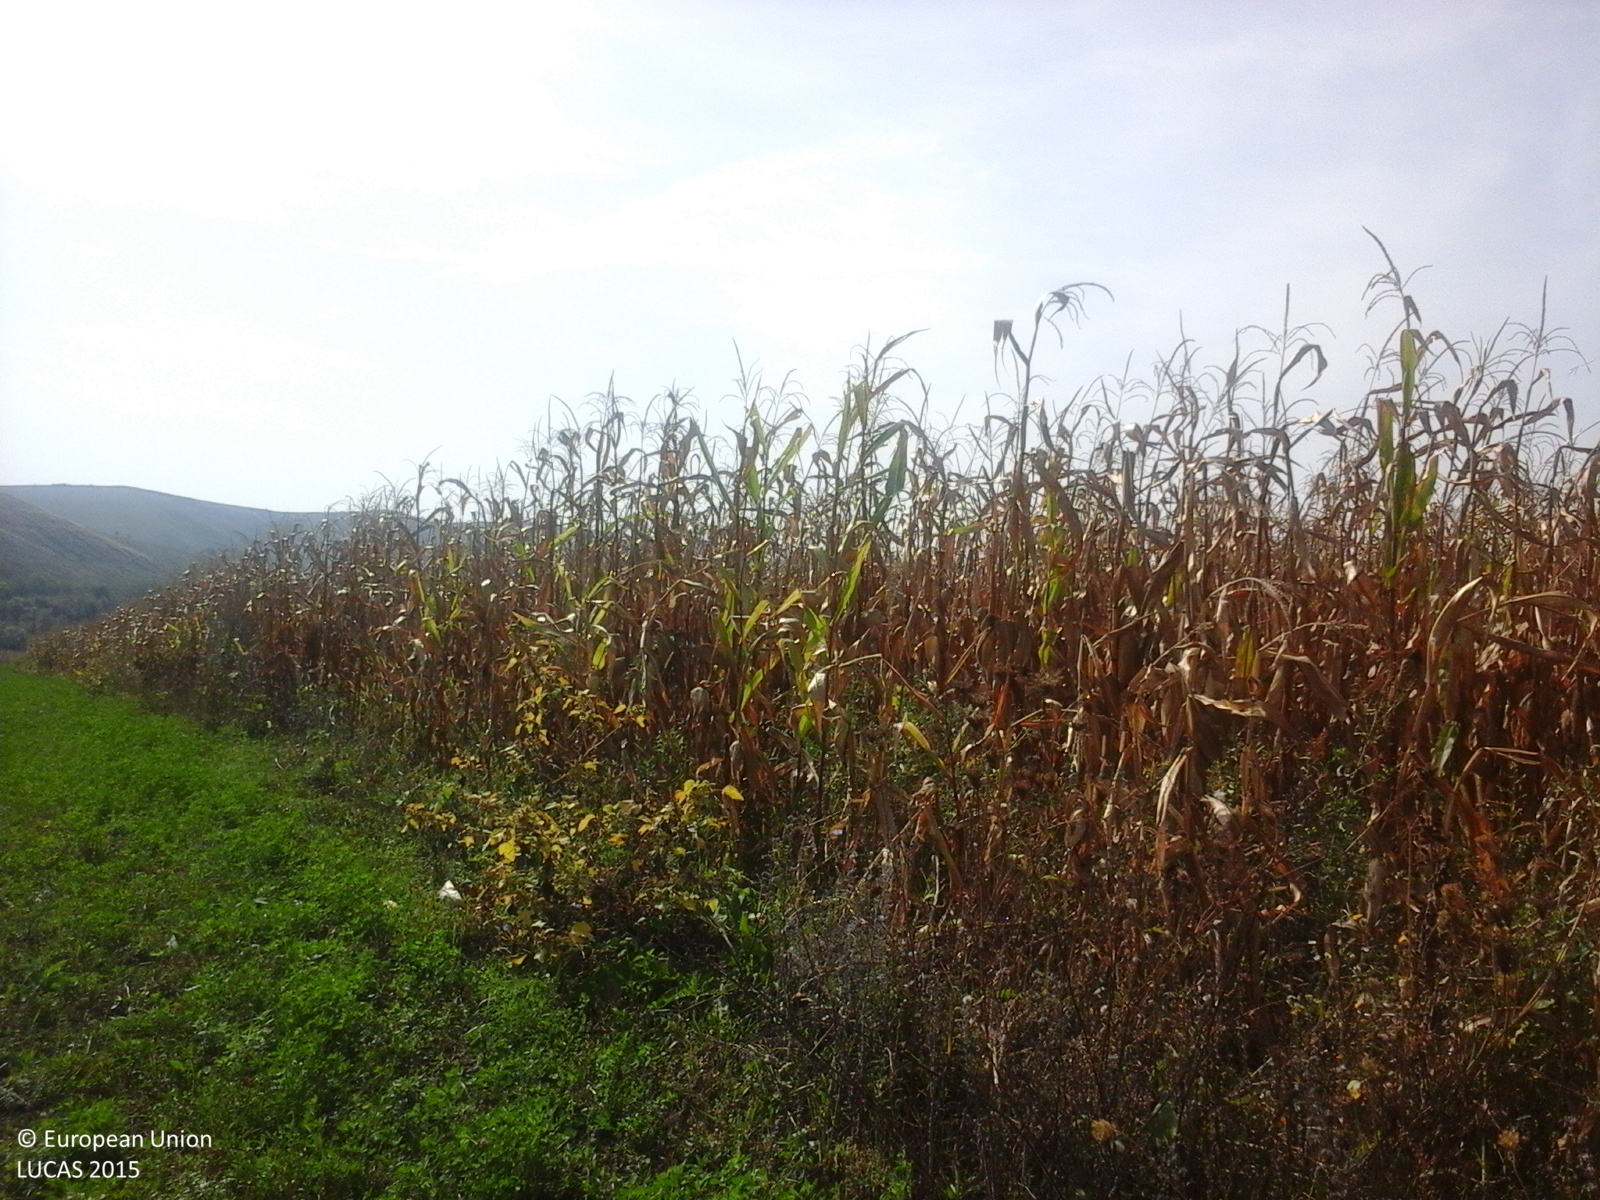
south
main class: Cropland
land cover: Maize
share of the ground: > 75 %
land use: Agriculture (excluding fallow land and kitchen gardens)
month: September
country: RO
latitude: 46.8615
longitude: 24.0502
